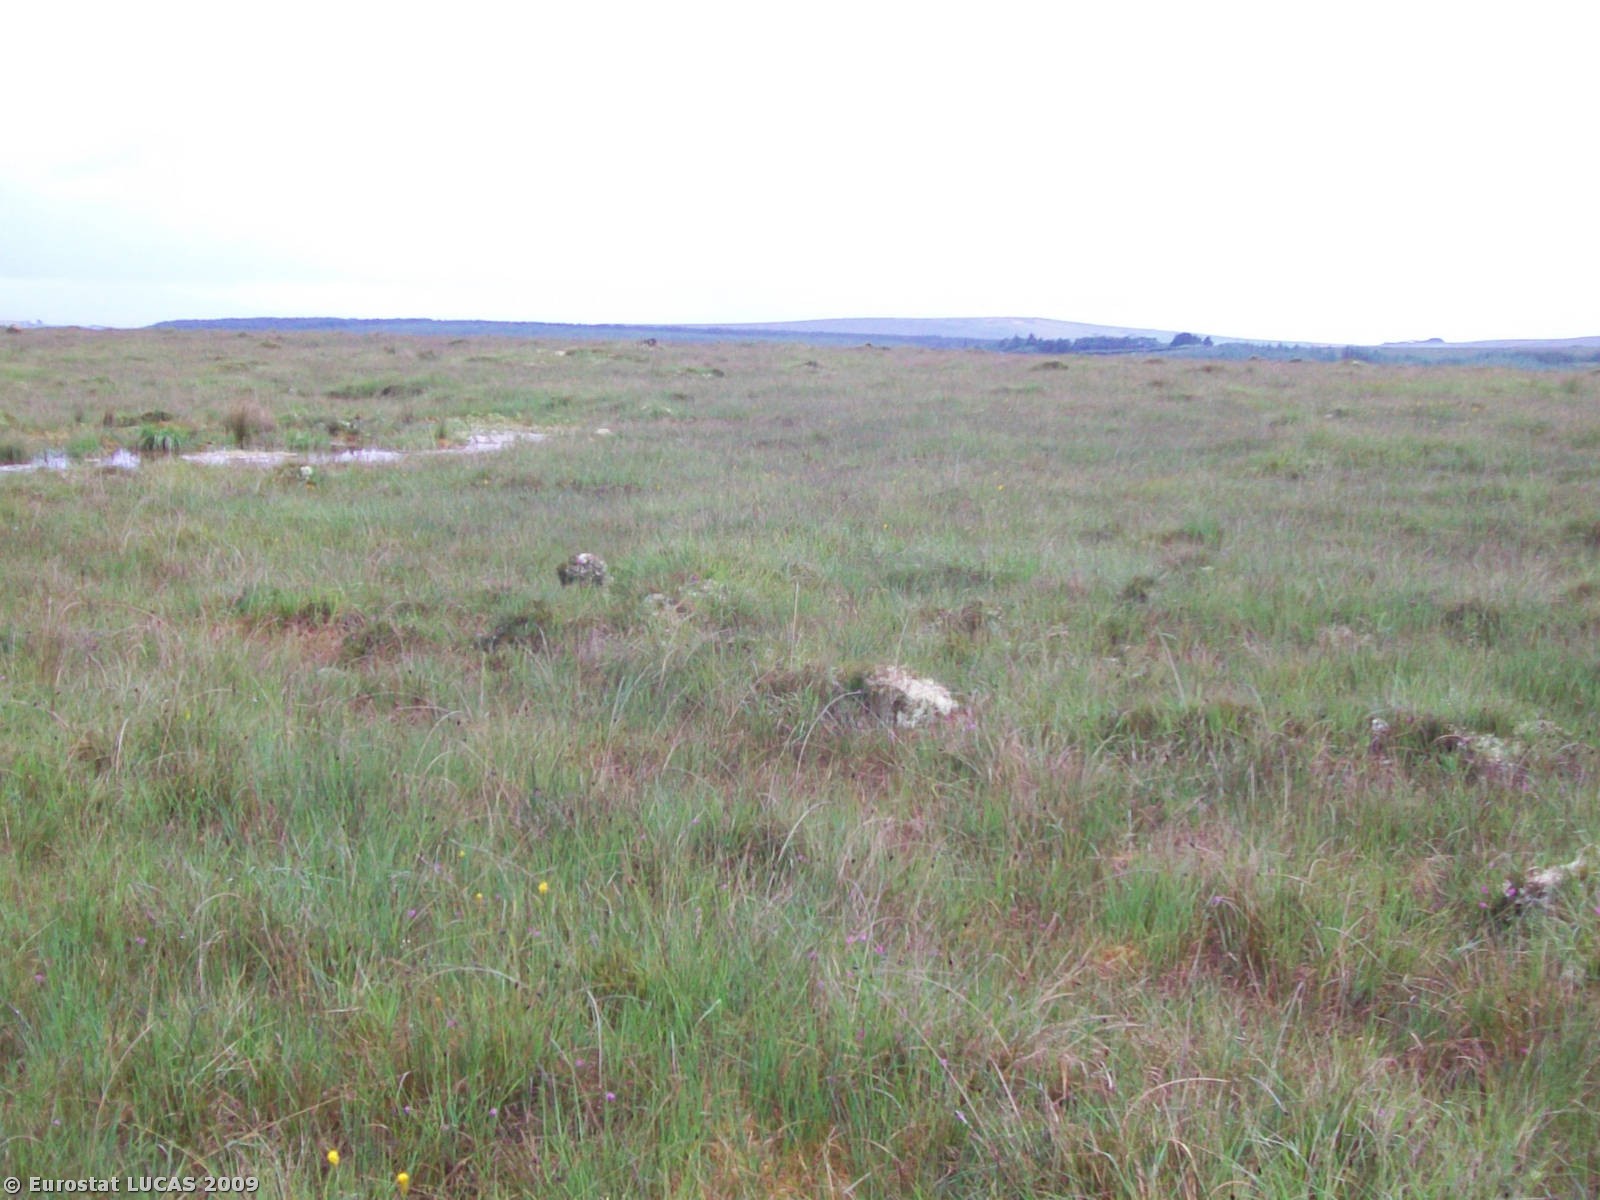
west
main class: Wetlands
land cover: Peatbogs
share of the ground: > 75 %
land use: Unused
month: July
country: IE
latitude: 53.9955
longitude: -9.7522
